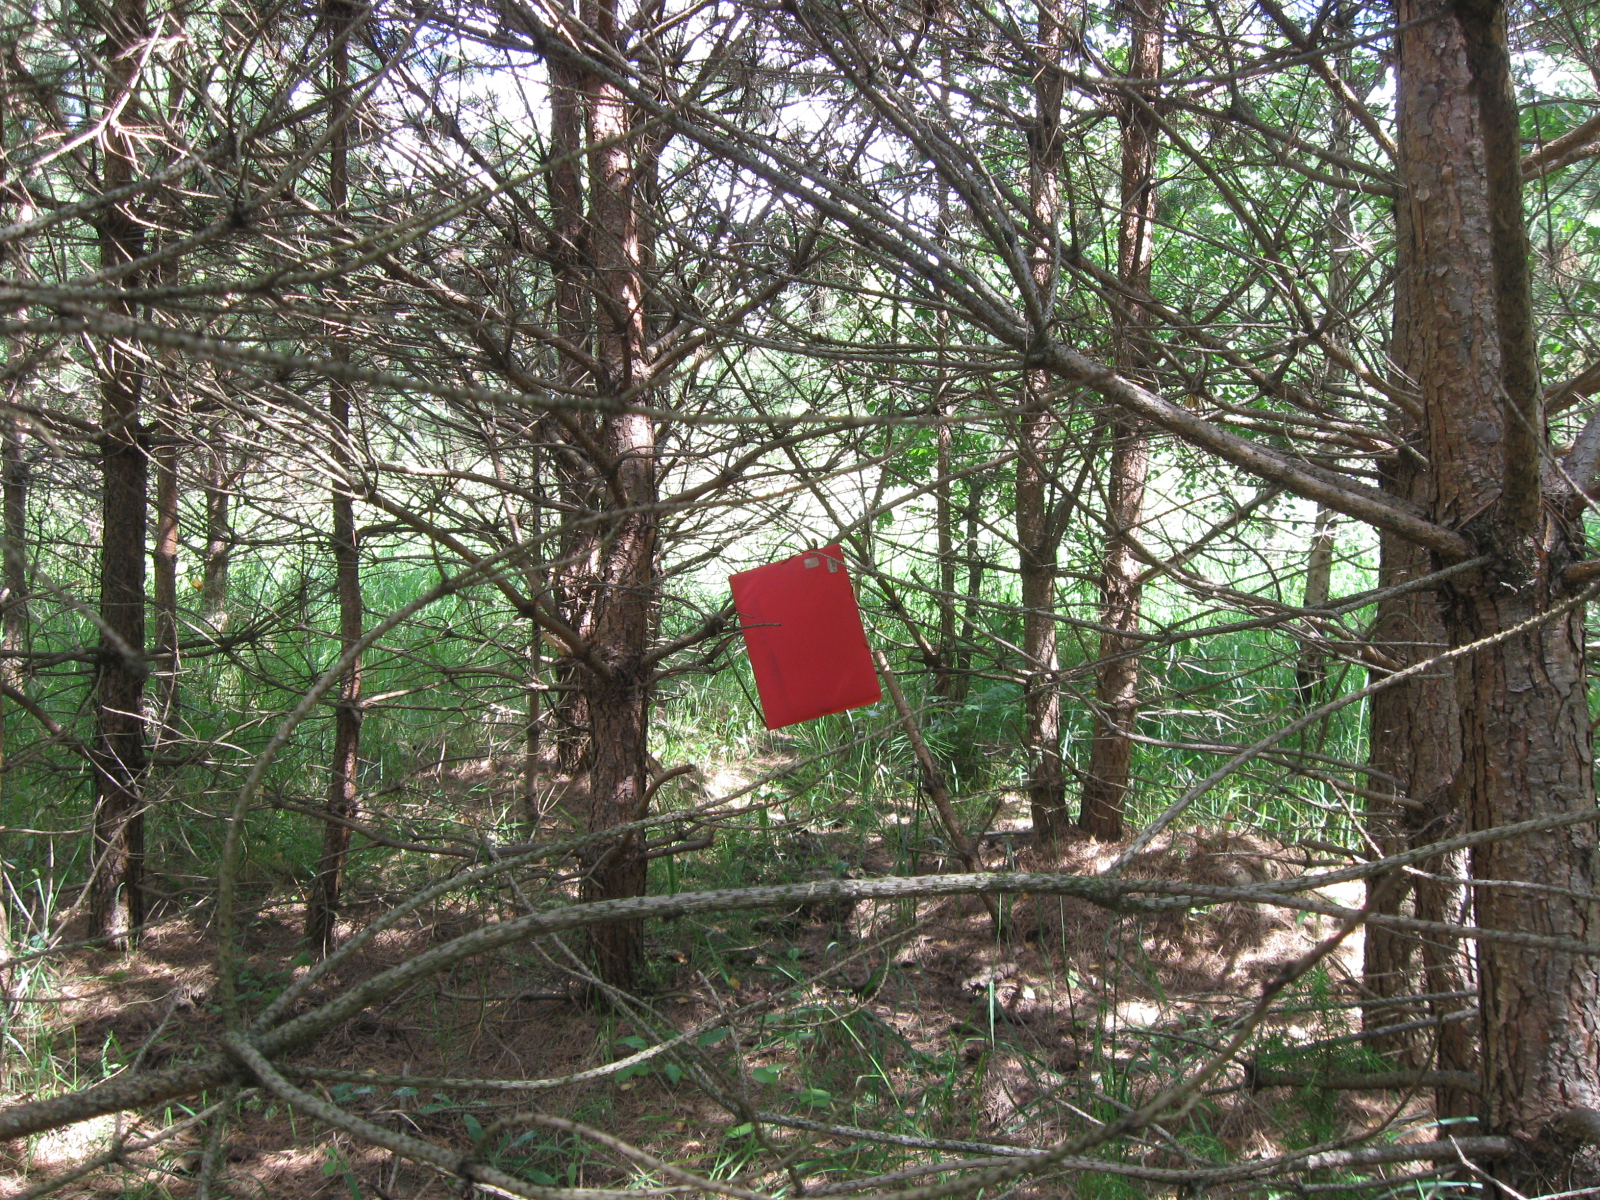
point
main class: Woodland
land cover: Pine dominated coniferous woodland
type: hemiboreal forest and nemoral coniferous forest and mixed broadleaved-coniferous forest
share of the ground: > 75 %
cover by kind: coniferous forest trees 95 %, herbaceous plants 5 %
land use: Forestry
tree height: < 5 m
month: July
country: LT
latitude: 54.3632
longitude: 24.5558
